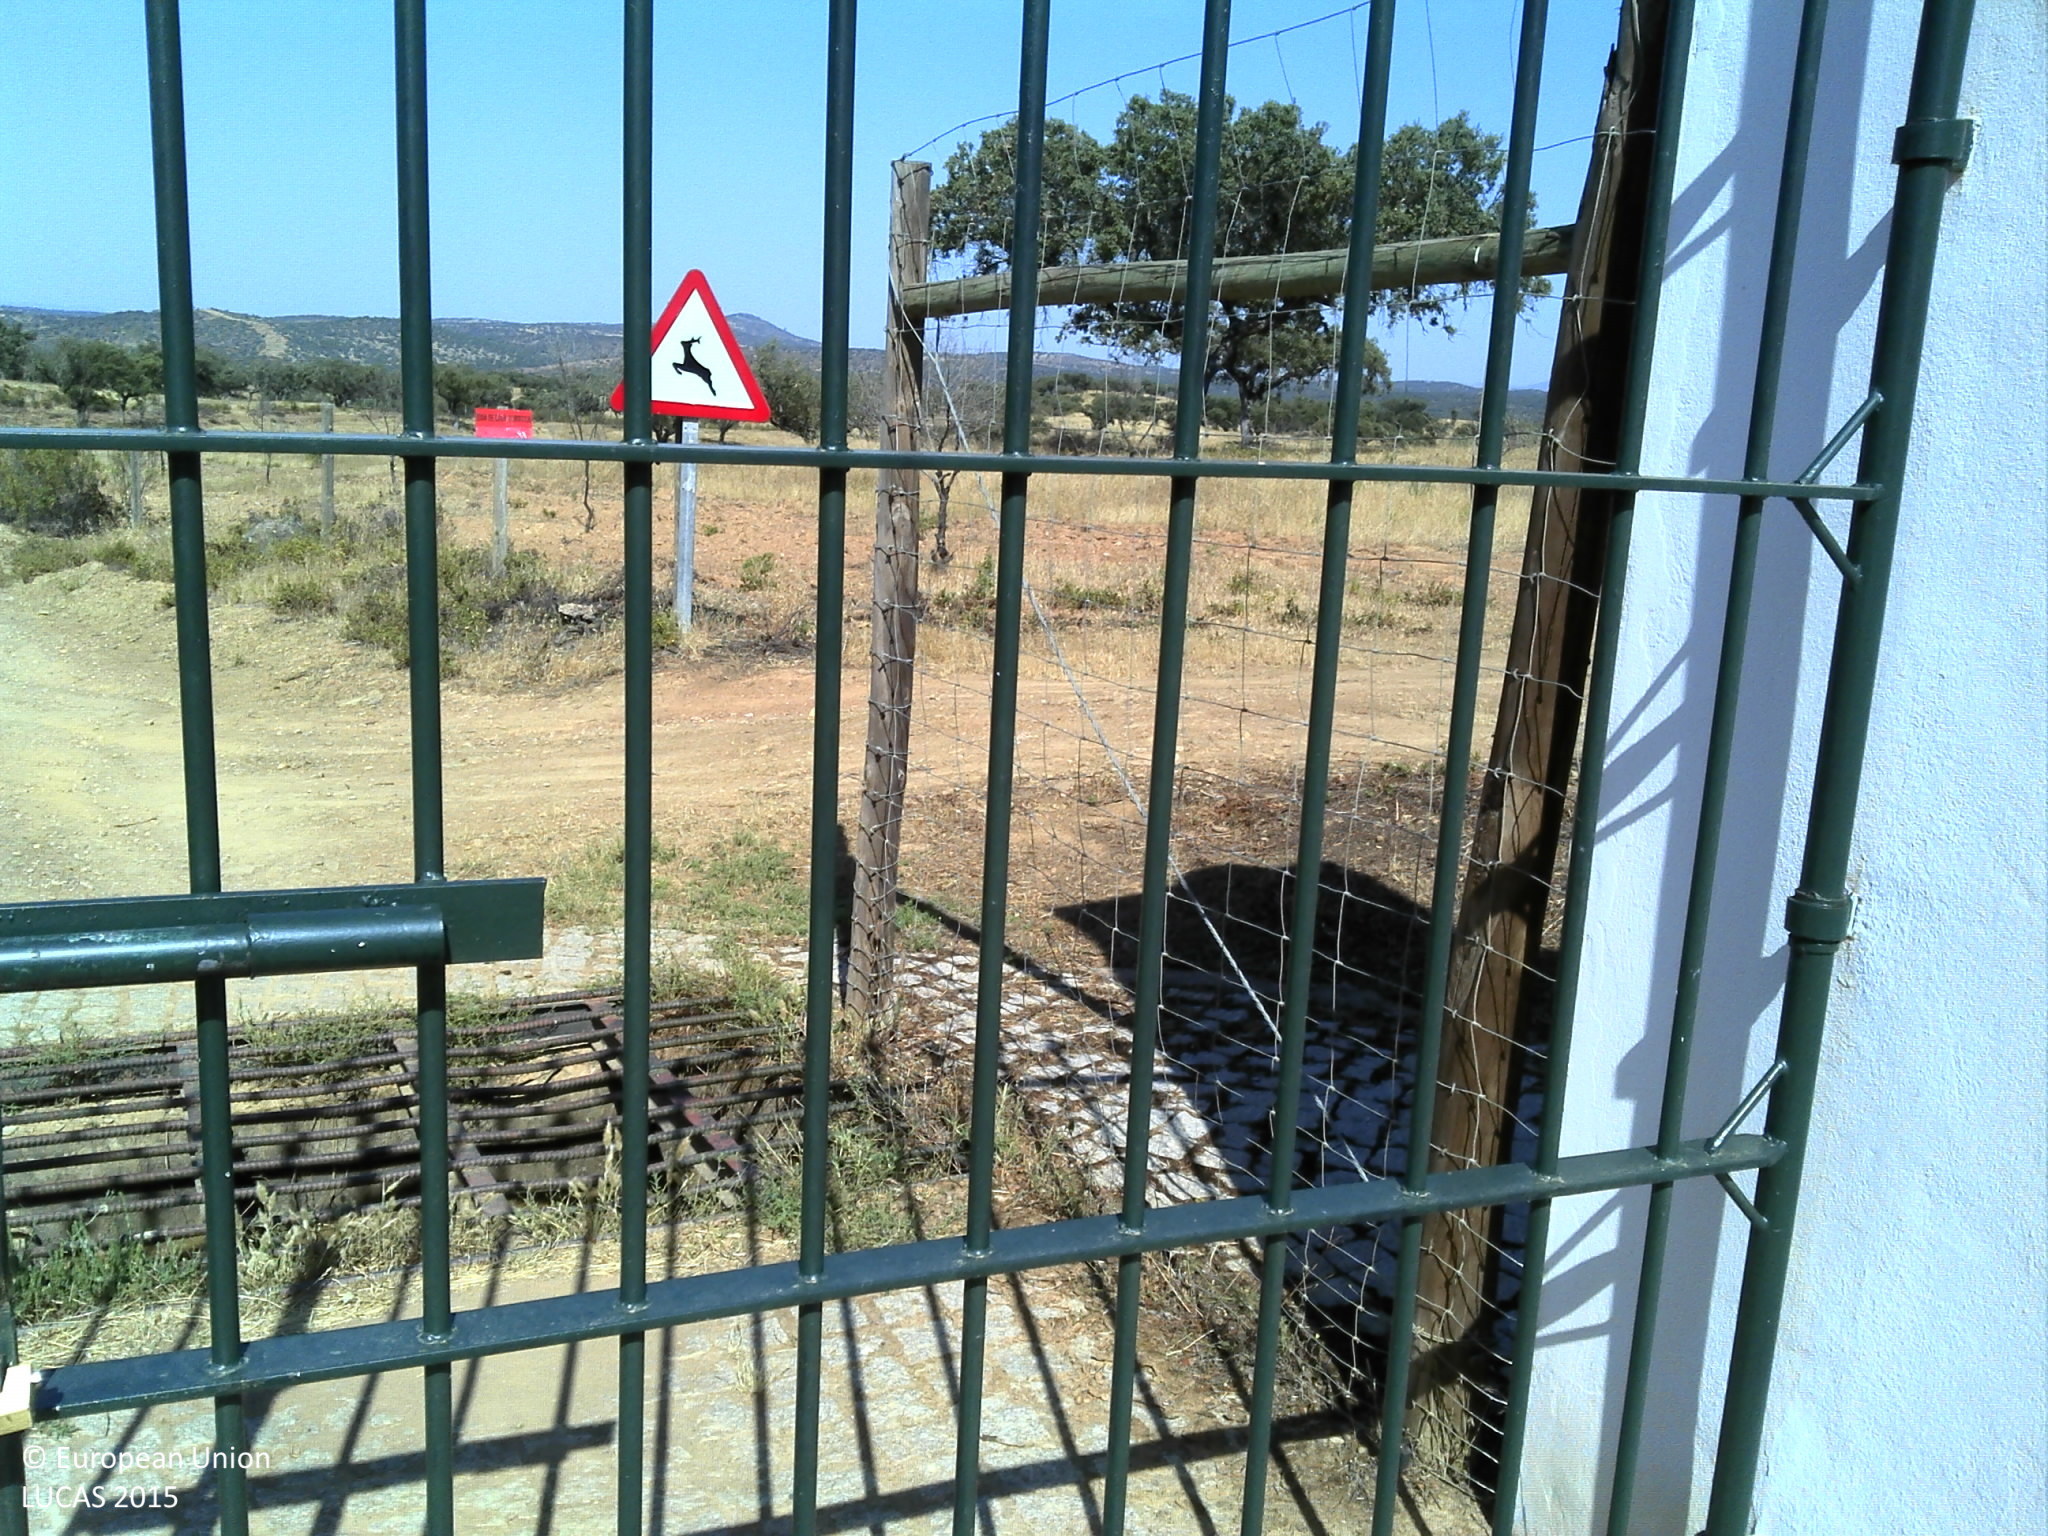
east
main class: Shrubland
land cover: Shrubland with sparse tree cover
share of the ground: > 75 %
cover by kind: shrubs 95 %, broadleaved forest trees 5 %
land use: Abandoned areas
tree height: > 5 m
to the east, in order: Shrubland with sparse tree cover; Broadleaved woodland; Shrubland without tree cover; Broadleaved woodland; Tracks; Broadleaved woodland; Shrubland without tree cover
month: June
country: PT
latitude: 37.6895
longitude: -7.4649
